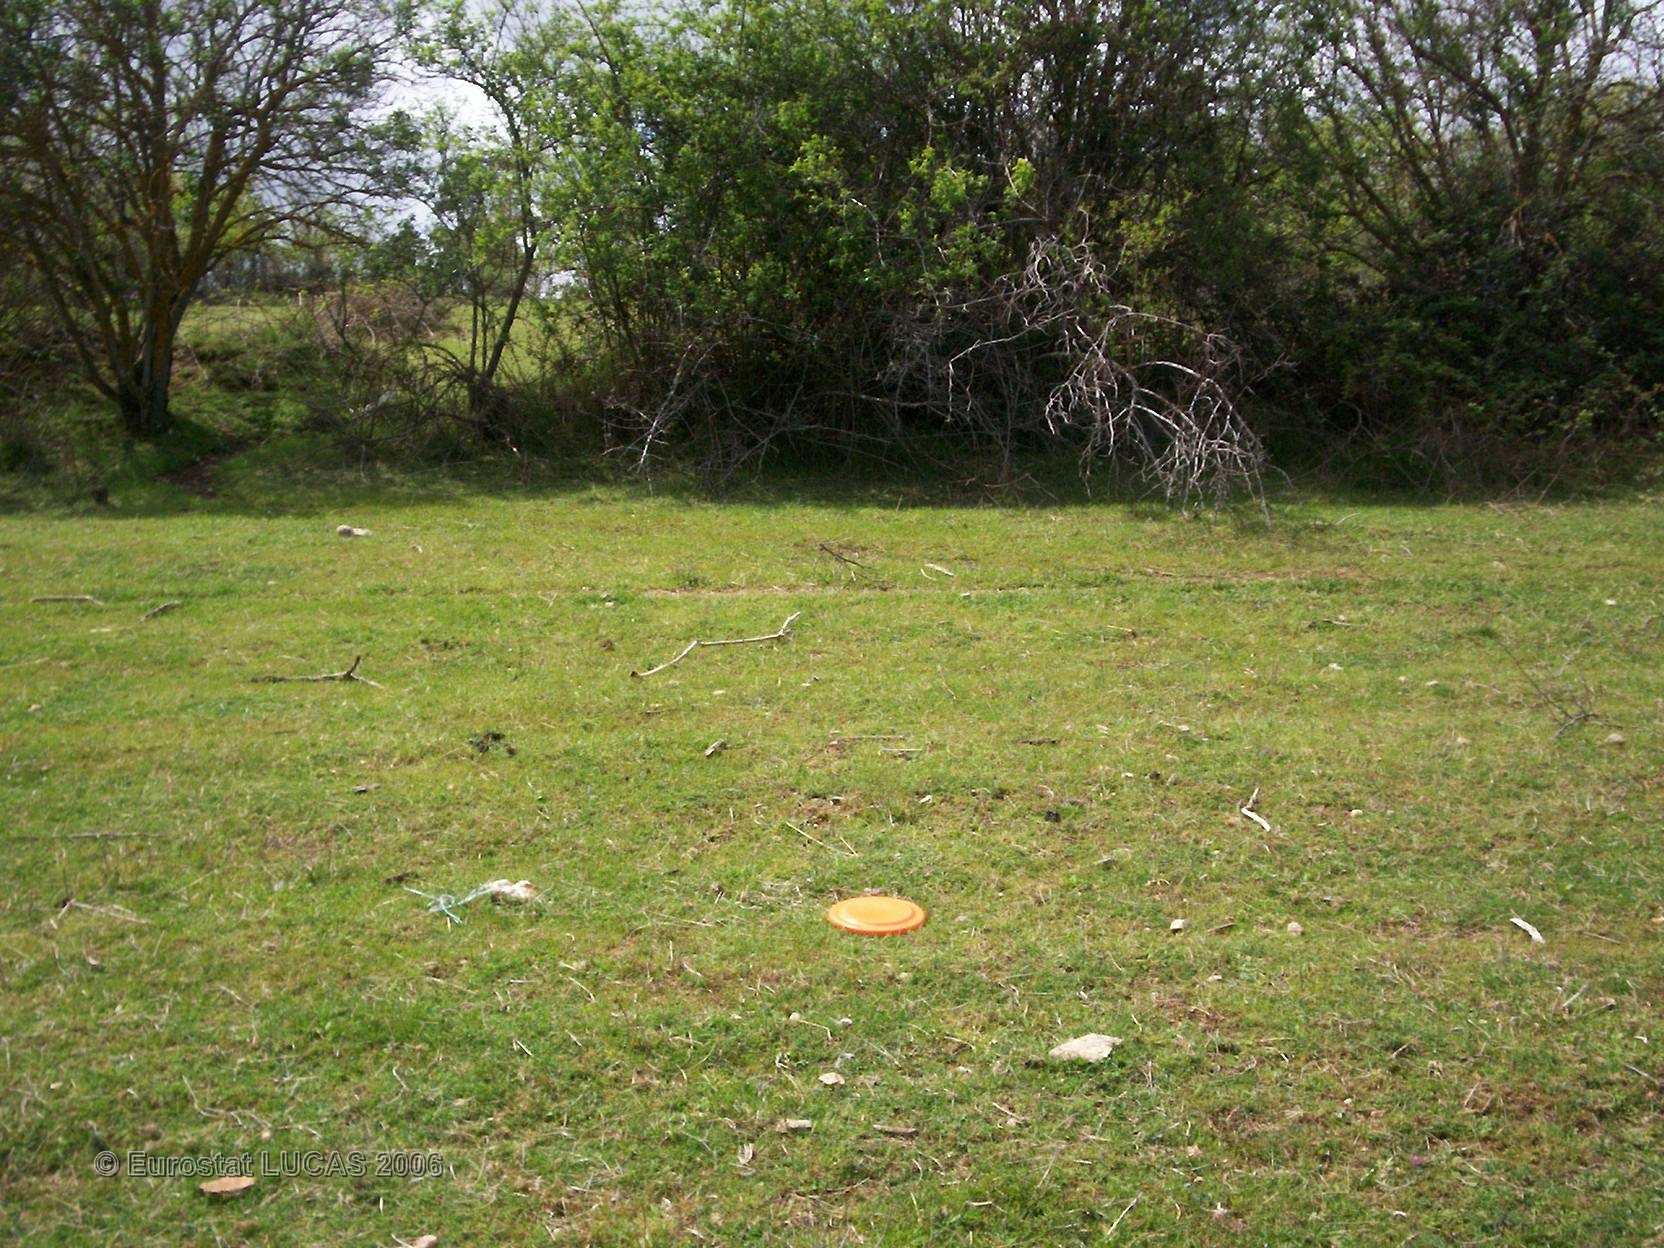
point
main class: Grassland
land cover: Grassland without tree/shrub cover
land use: Agriculture (excluding fallow land and kitchen gardens)
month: May
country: FR
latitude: 45.2023
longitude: 3.3187
